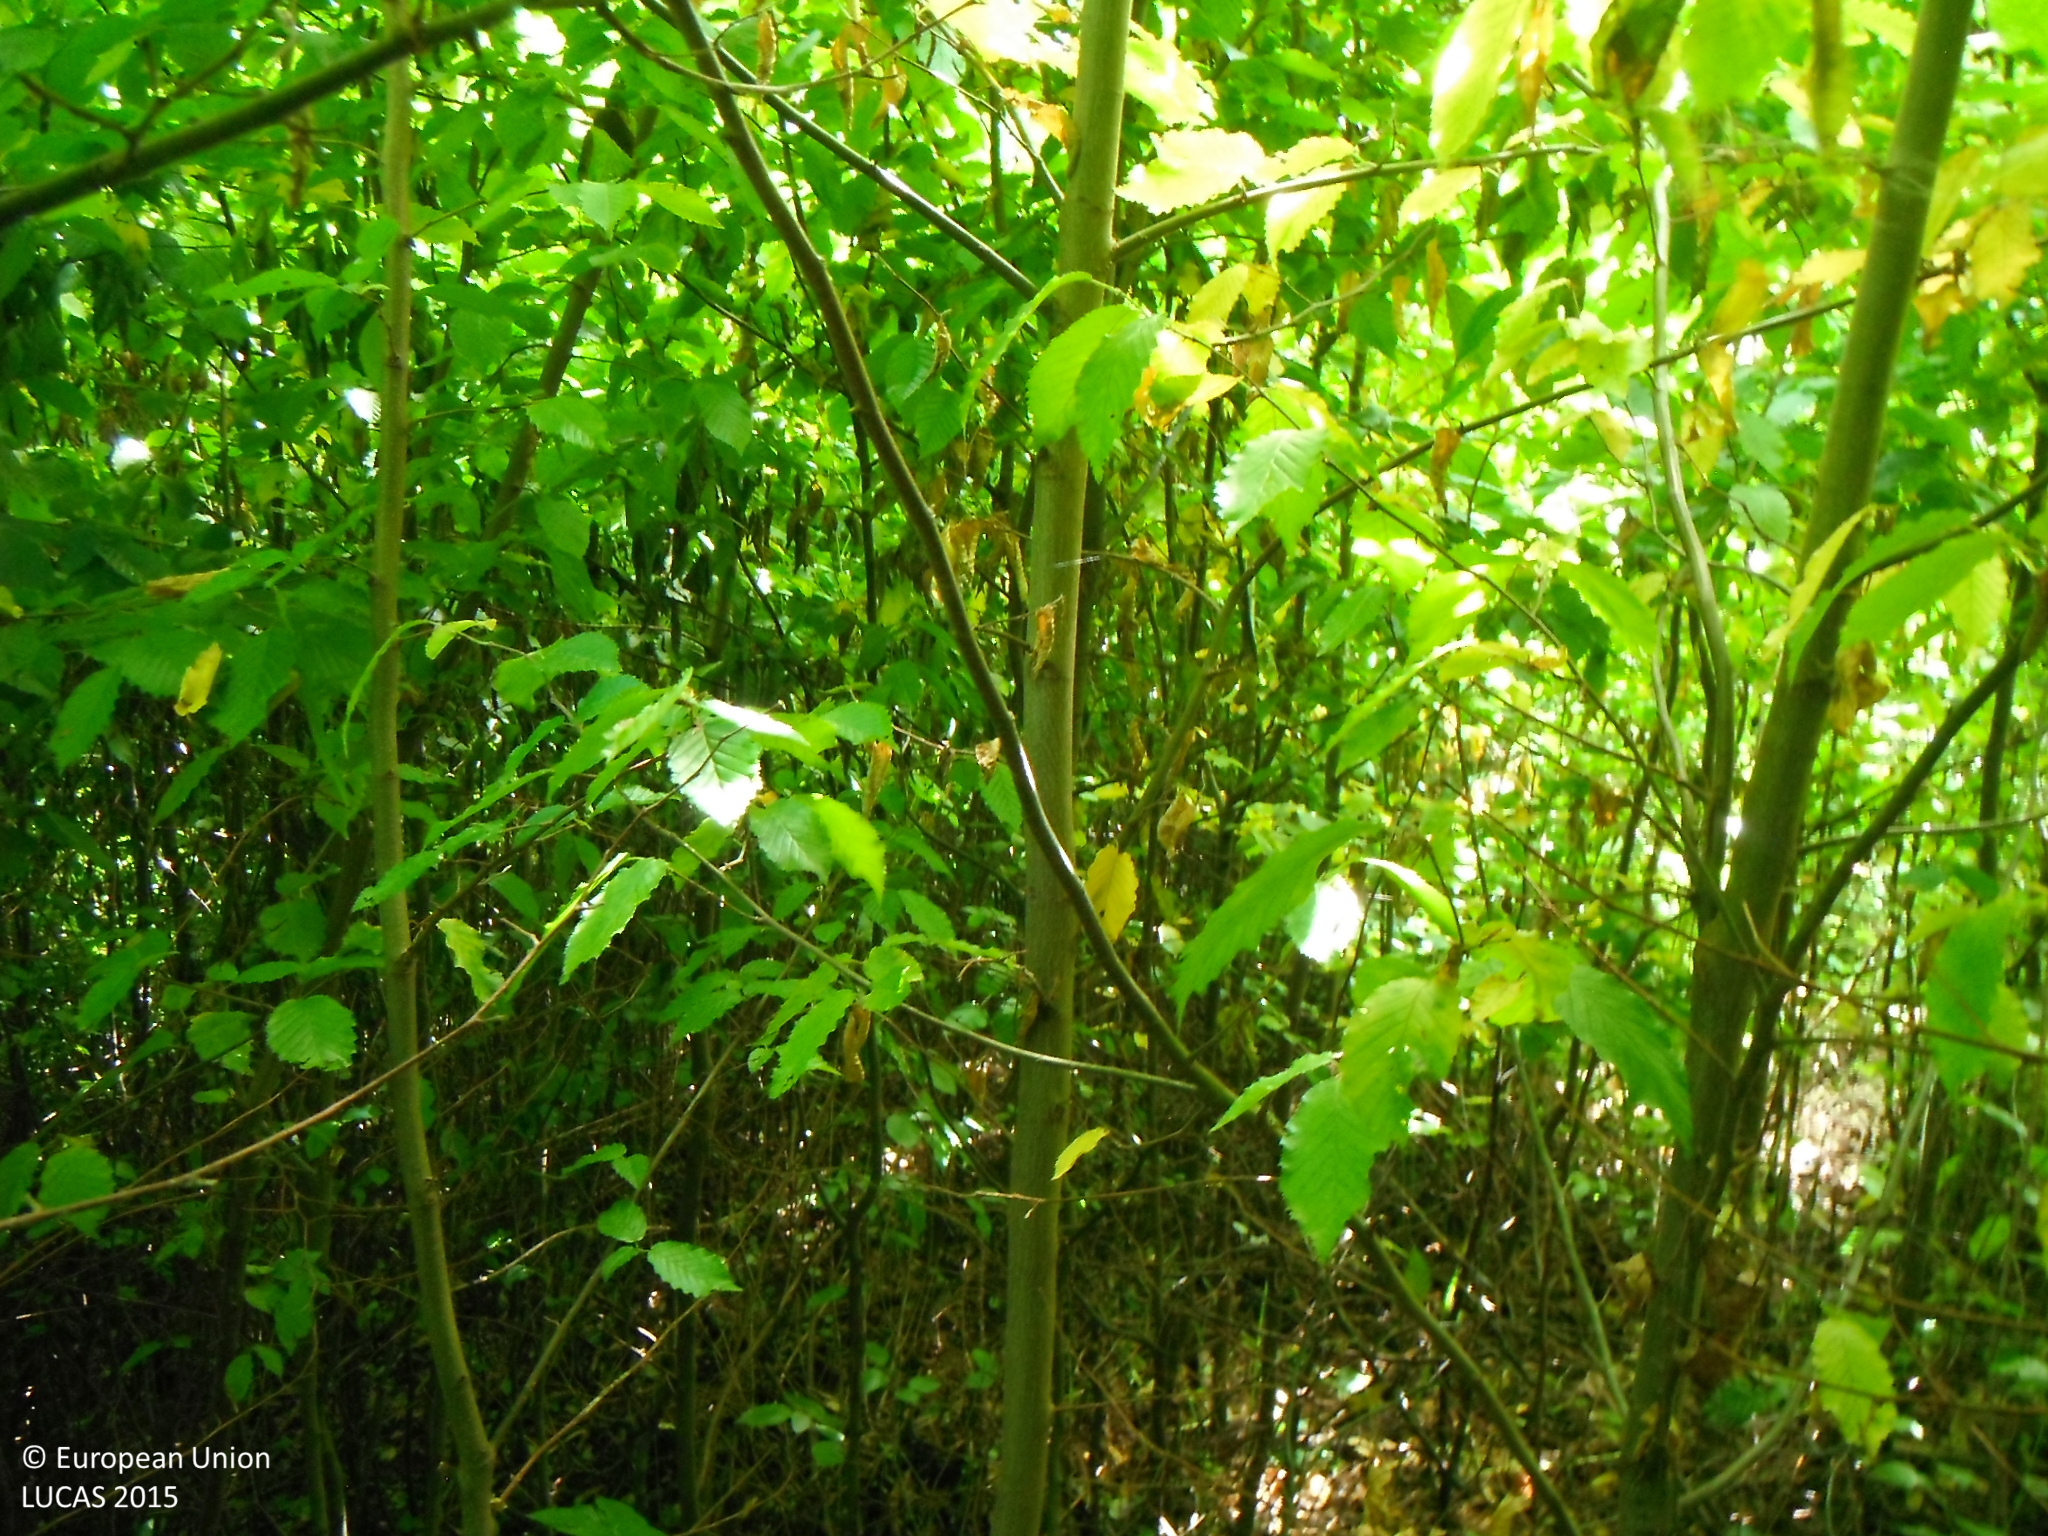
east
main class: Woodland
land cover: Broadleaved woodland
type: mesophytic deciduous forest
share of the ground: > 75 %
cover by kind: broadleaved forest trees 100 %
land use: Forestry
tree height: > 5 m
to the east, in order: Broadleaved woodland; Grassland without tree/shrub cover; Tracks; Grassland without tree/shrub cover; Broadleaved woodland
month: June
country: SK
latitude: 48.2123
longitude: 19.4847
